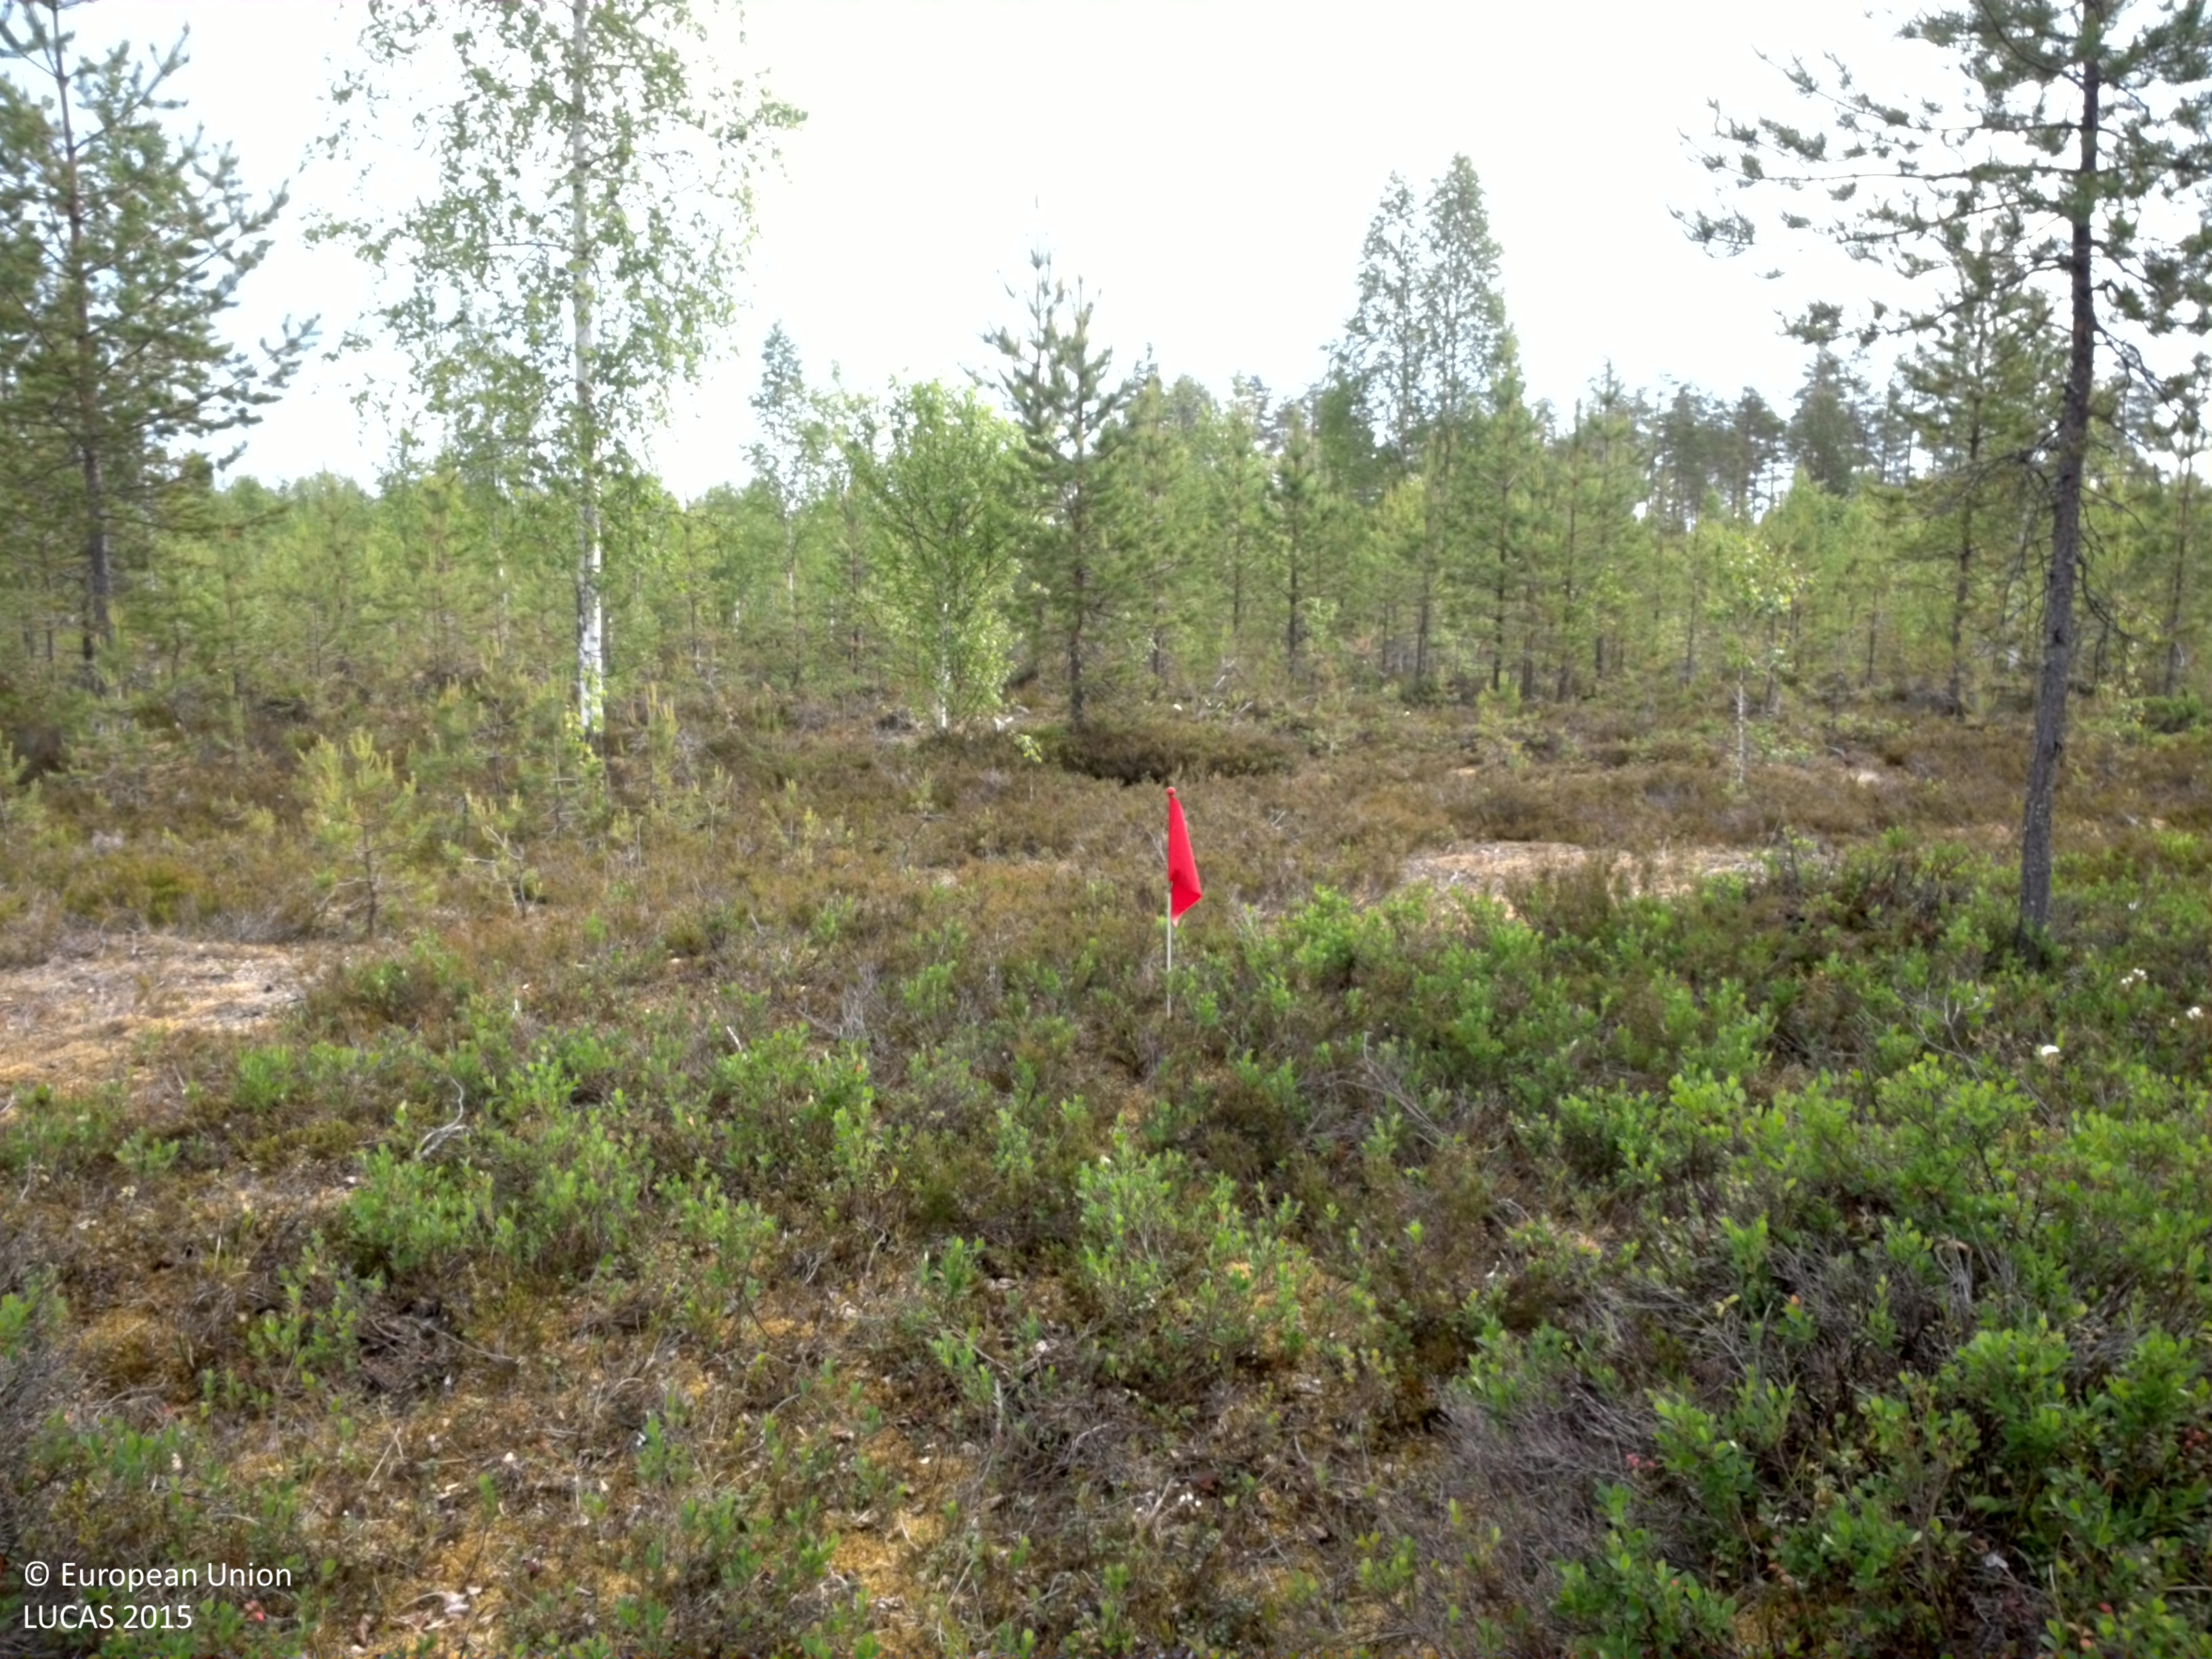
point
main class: Woodland
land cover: Pine dominated mixed woodland
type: boreal forest
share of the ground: 25 - 50 %
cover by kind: shrubs 40 %, coniferous forest trees 30 %, lichens and mosses 20 %, broadleaved forest trees 10 %
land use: Forestry
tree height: < 5 m
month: July
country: SE
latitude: 64.5018
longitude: 20.8266
